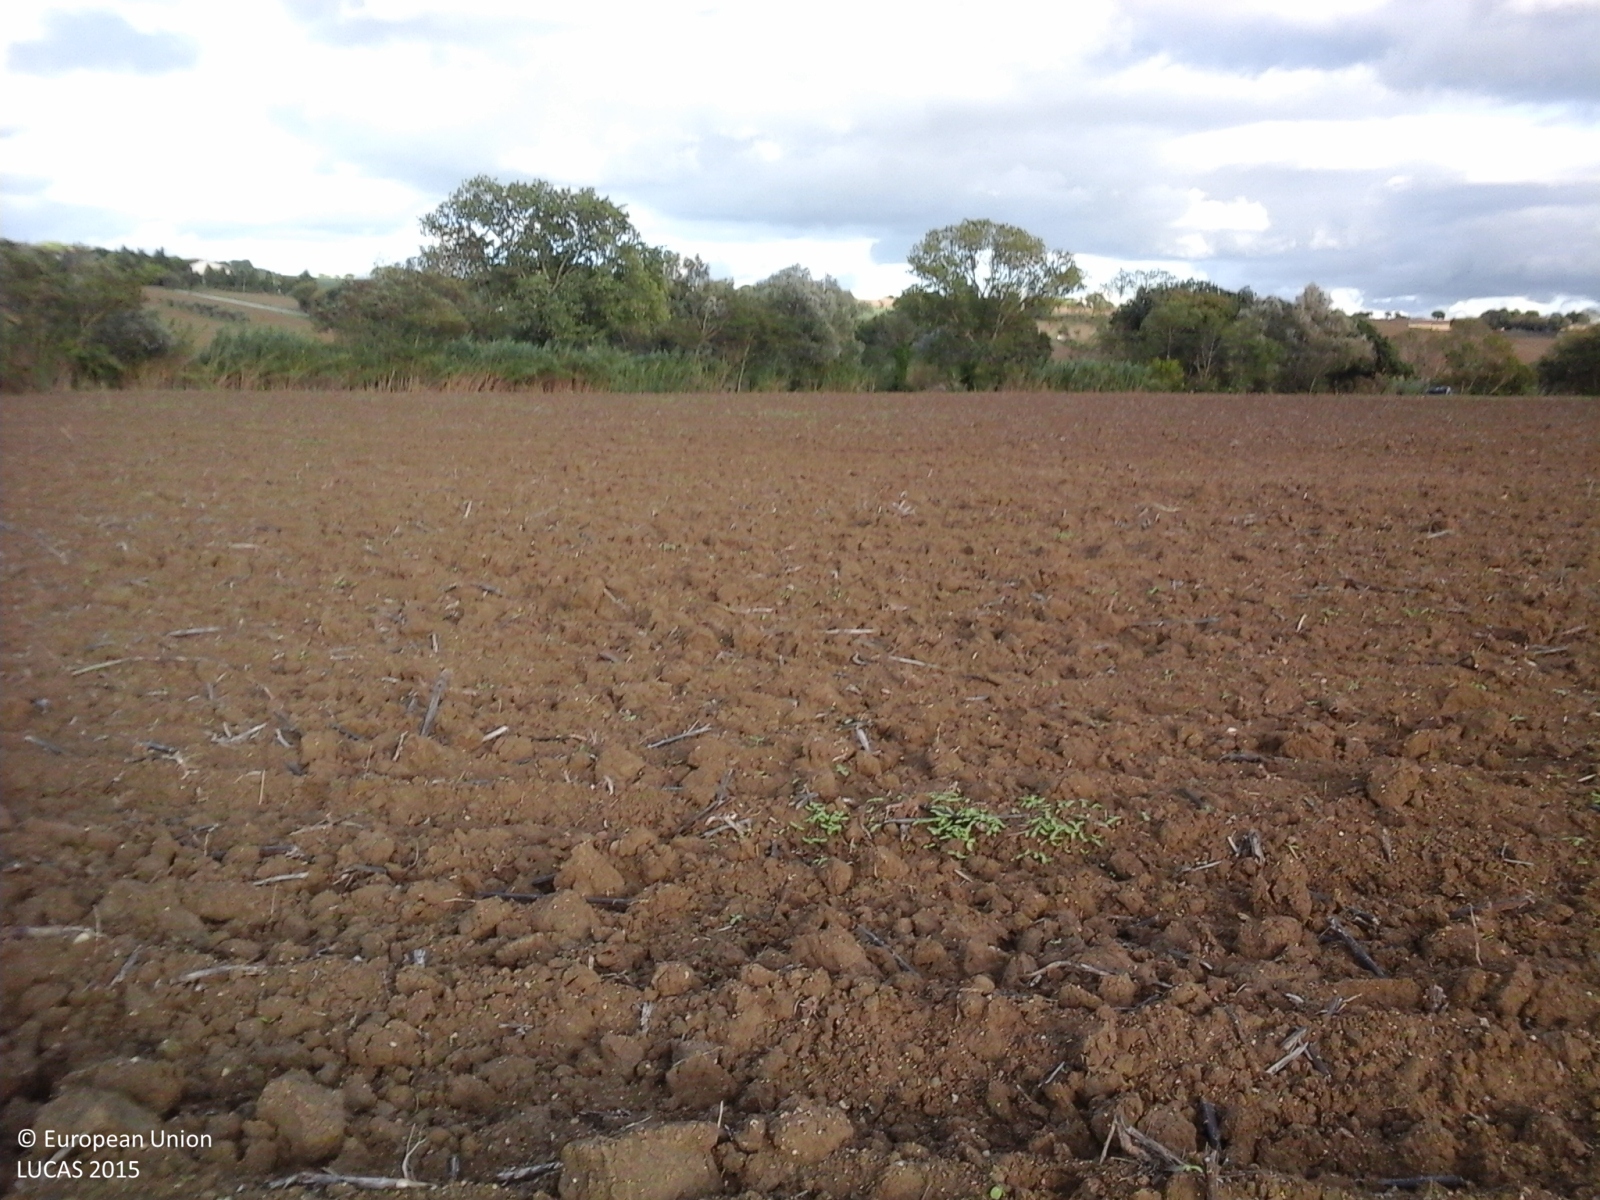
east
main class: Cropland
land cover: Sunflower
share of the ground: < 10 %
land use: Agriculture (excluding fallow land and kitchen gardens)
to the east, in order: Sunflower; Ditches and canals; Durum wheat; Broadleaved woodland; Rivers and streams; Broadleaved woodland; Sunflower; Abandoned hedges; Ditches and canals; Abandoned hedges; Other bare soil
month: October
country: IT
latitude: 43.6677
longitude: 13.2540
